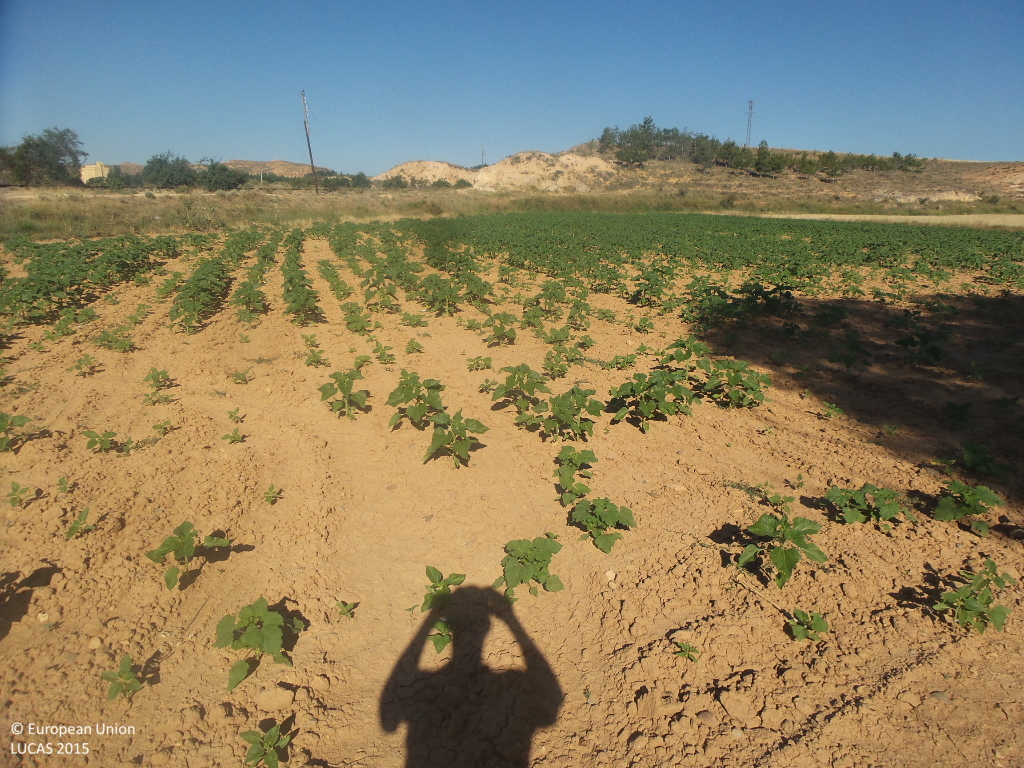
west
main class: Cropland
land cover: Sunflower
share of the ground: < 10 %
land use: Agriculture (excluding fallow land and kitchen gardens)
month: July
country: ES
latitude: 41.3703
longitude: -2.1655
